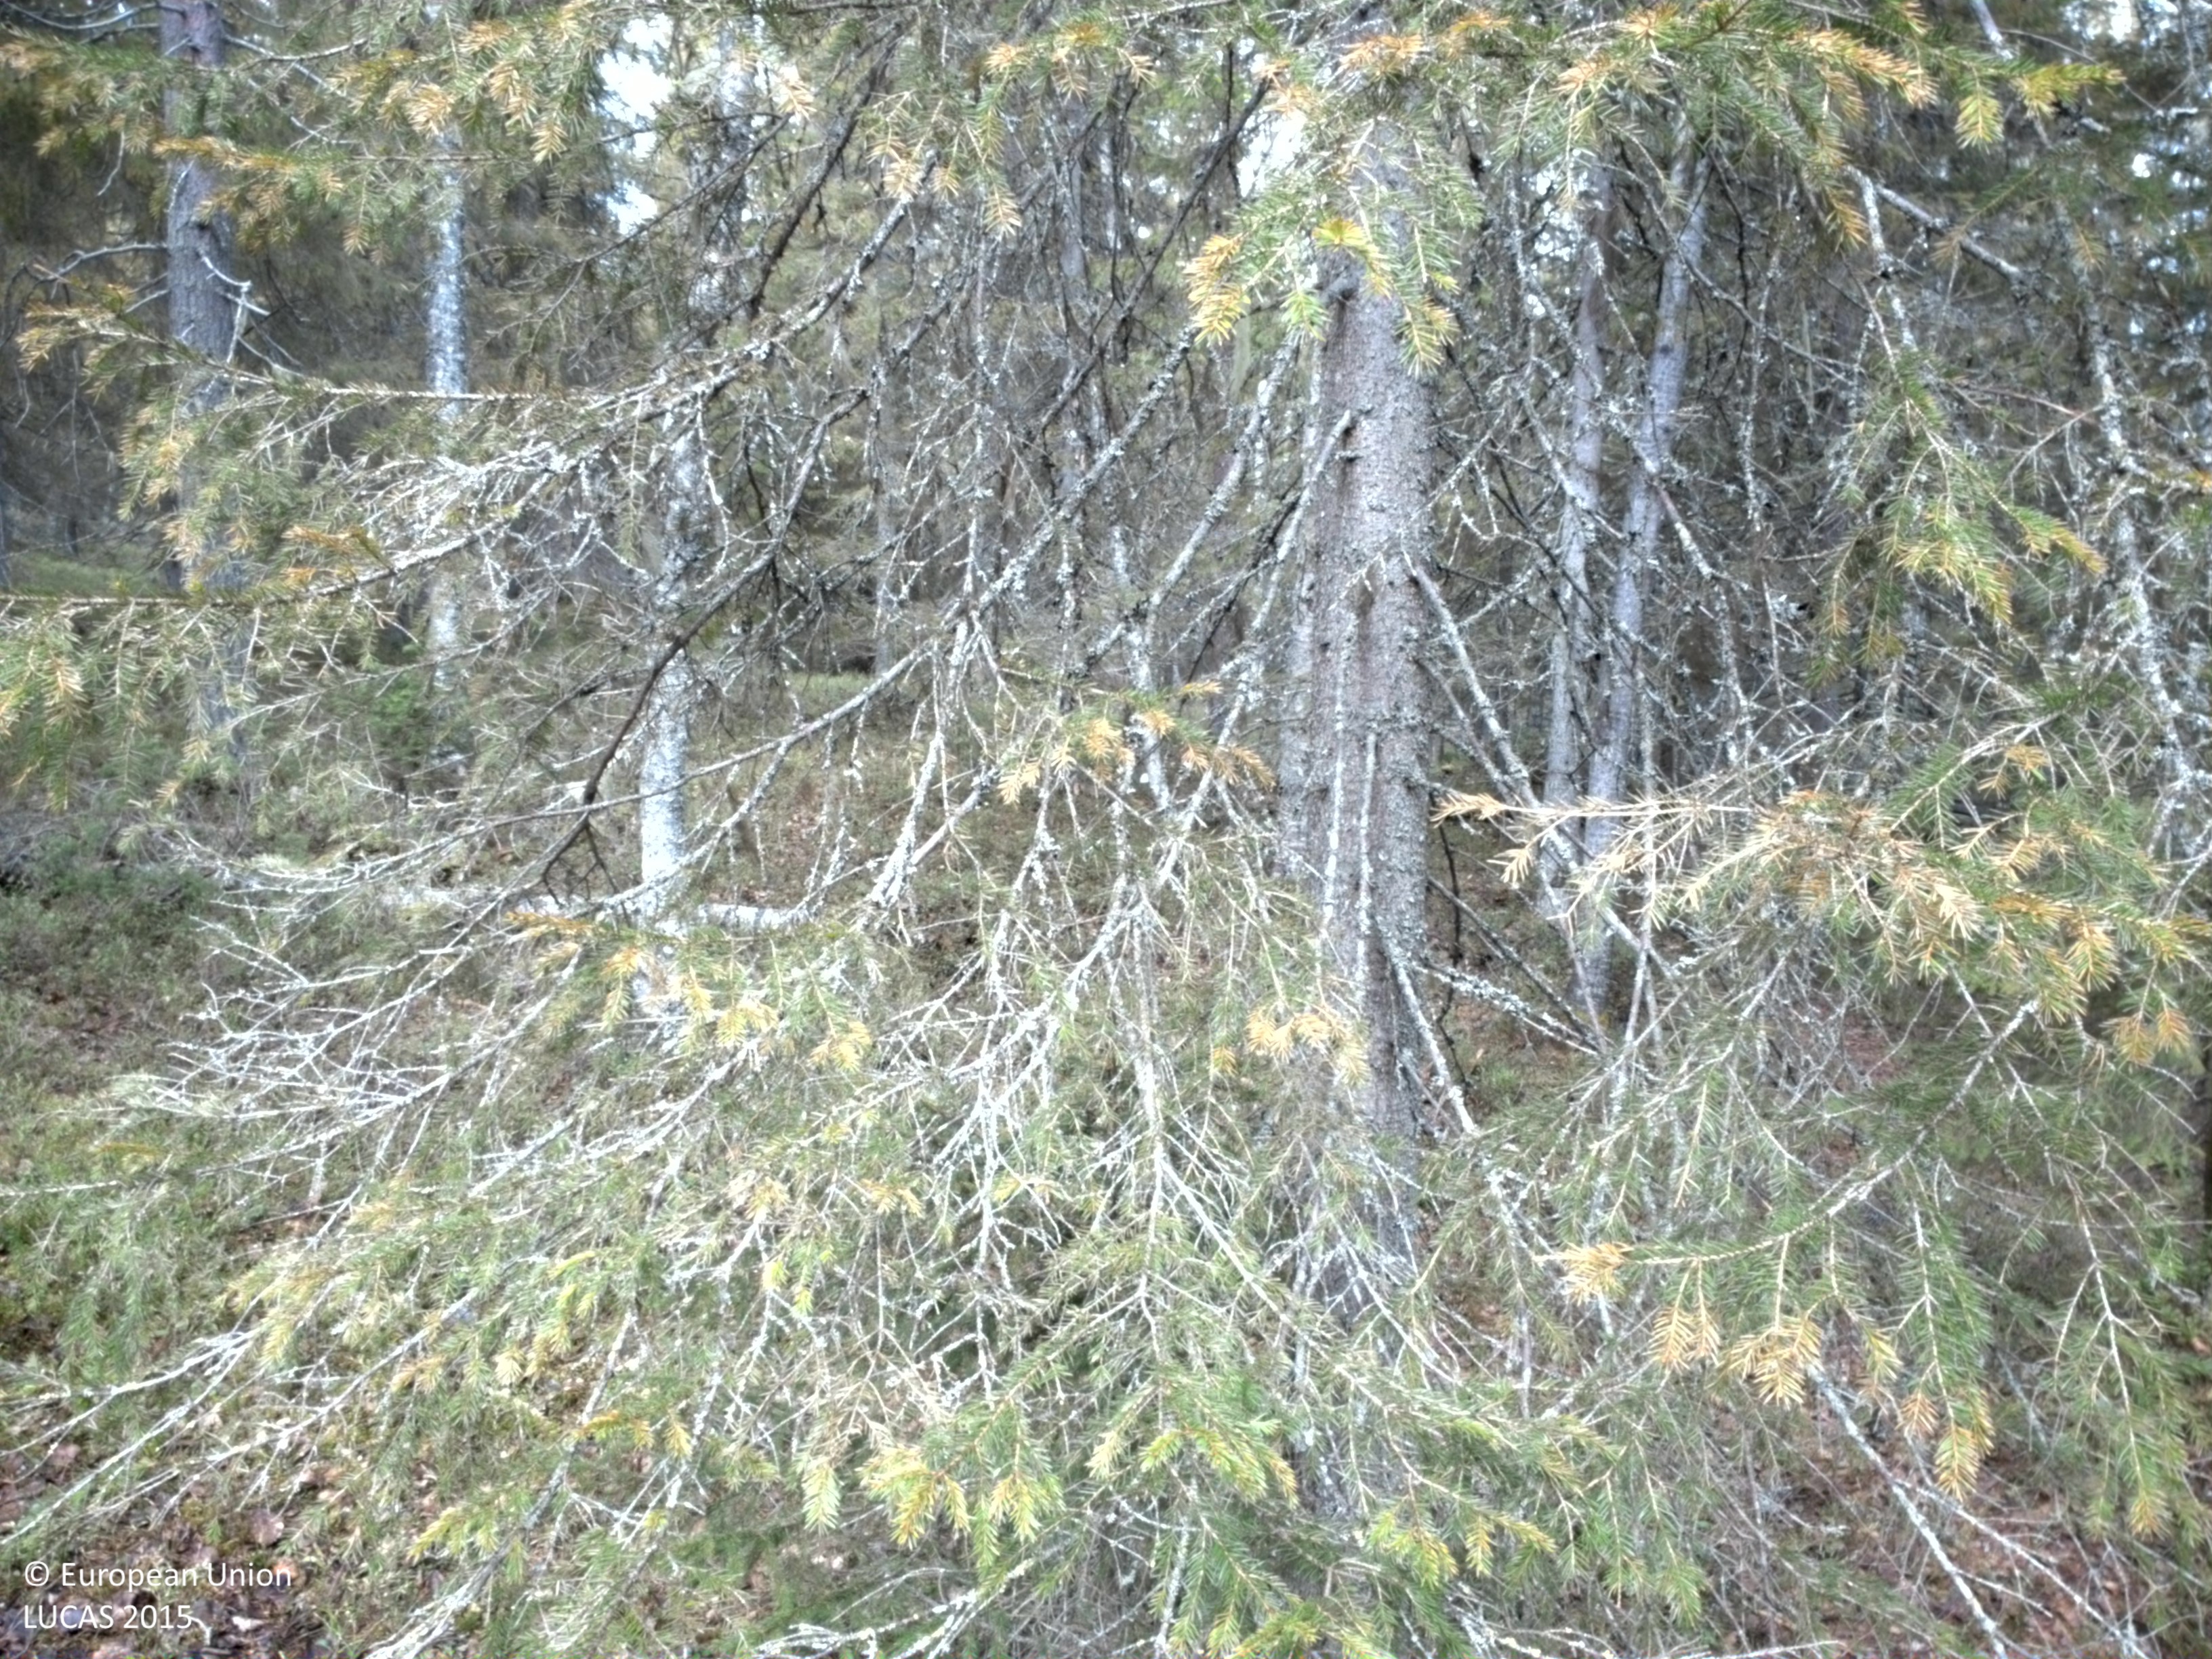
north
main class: Woodland
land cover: Spruce dominated coniferous woodland
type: boreal forest
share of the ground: 50 - 75 %
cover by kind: coniferous forest trees 60 %, shrubs 25 %, broadleaved forest trees 15 %
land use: Forestry
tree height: > 5 m
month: June
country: SE
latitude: 66.4593
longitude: 23.3781
